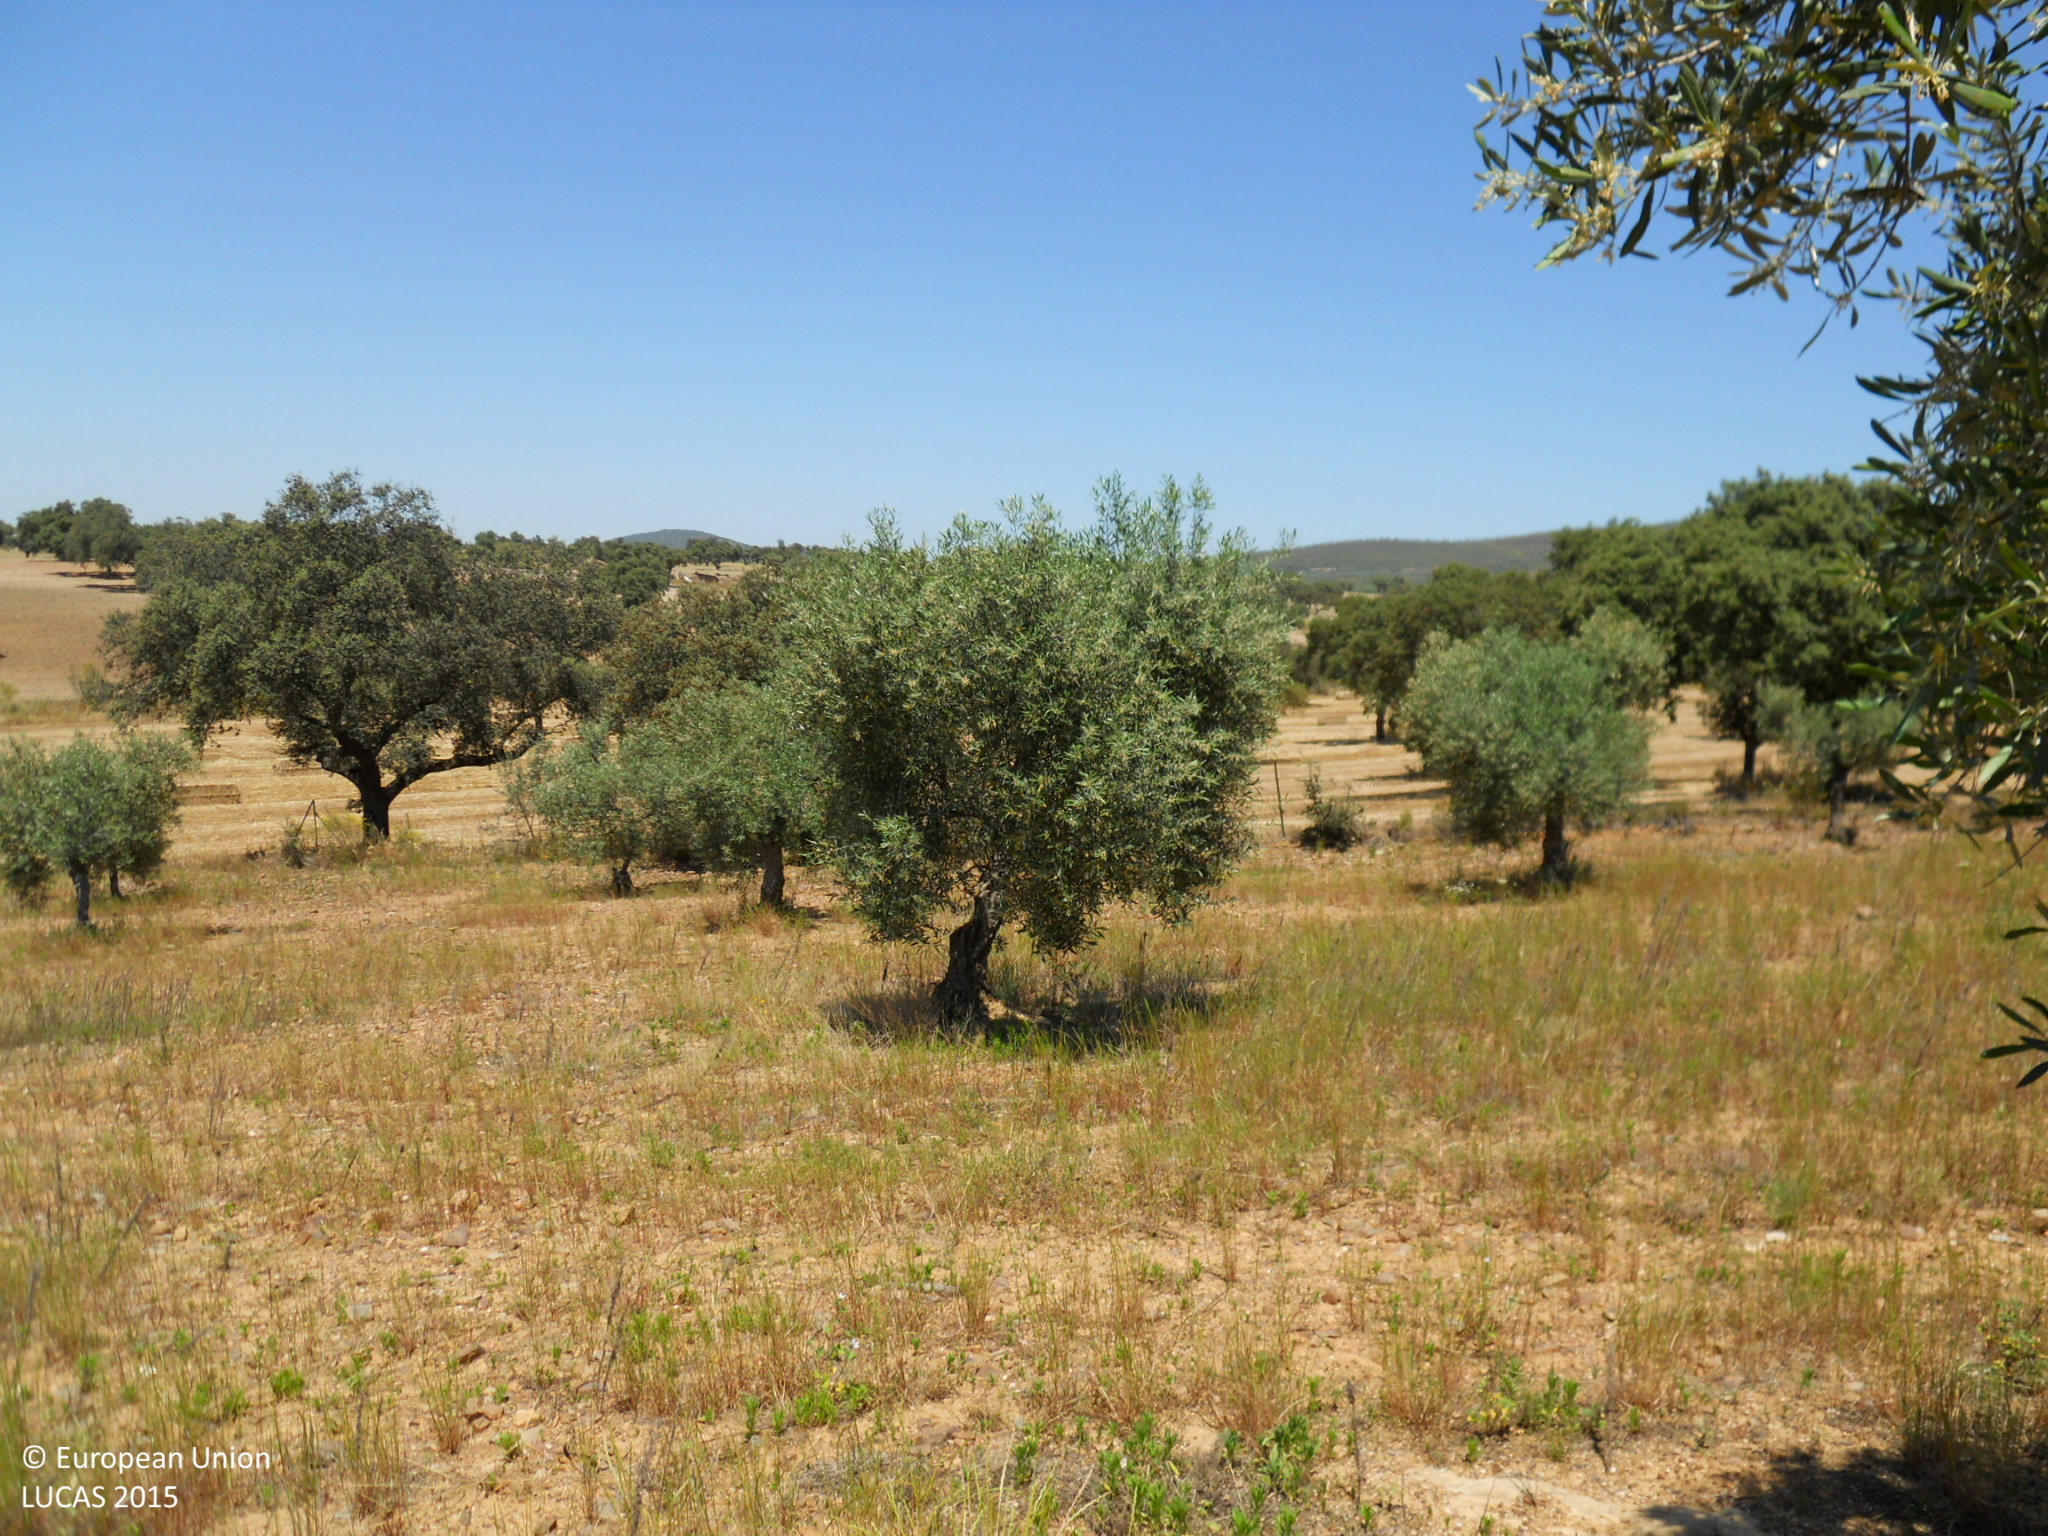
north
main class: Cropland
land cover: Olive groves
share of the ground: > 75 %
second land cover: Spontaneously vegetated surfaces
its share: 25 - 50 %
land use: Agriculture (excluding fallow land and kitchen gardens)
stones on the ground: > 50 %
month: May
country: ES
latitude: 38.9934
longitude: -6.2558
